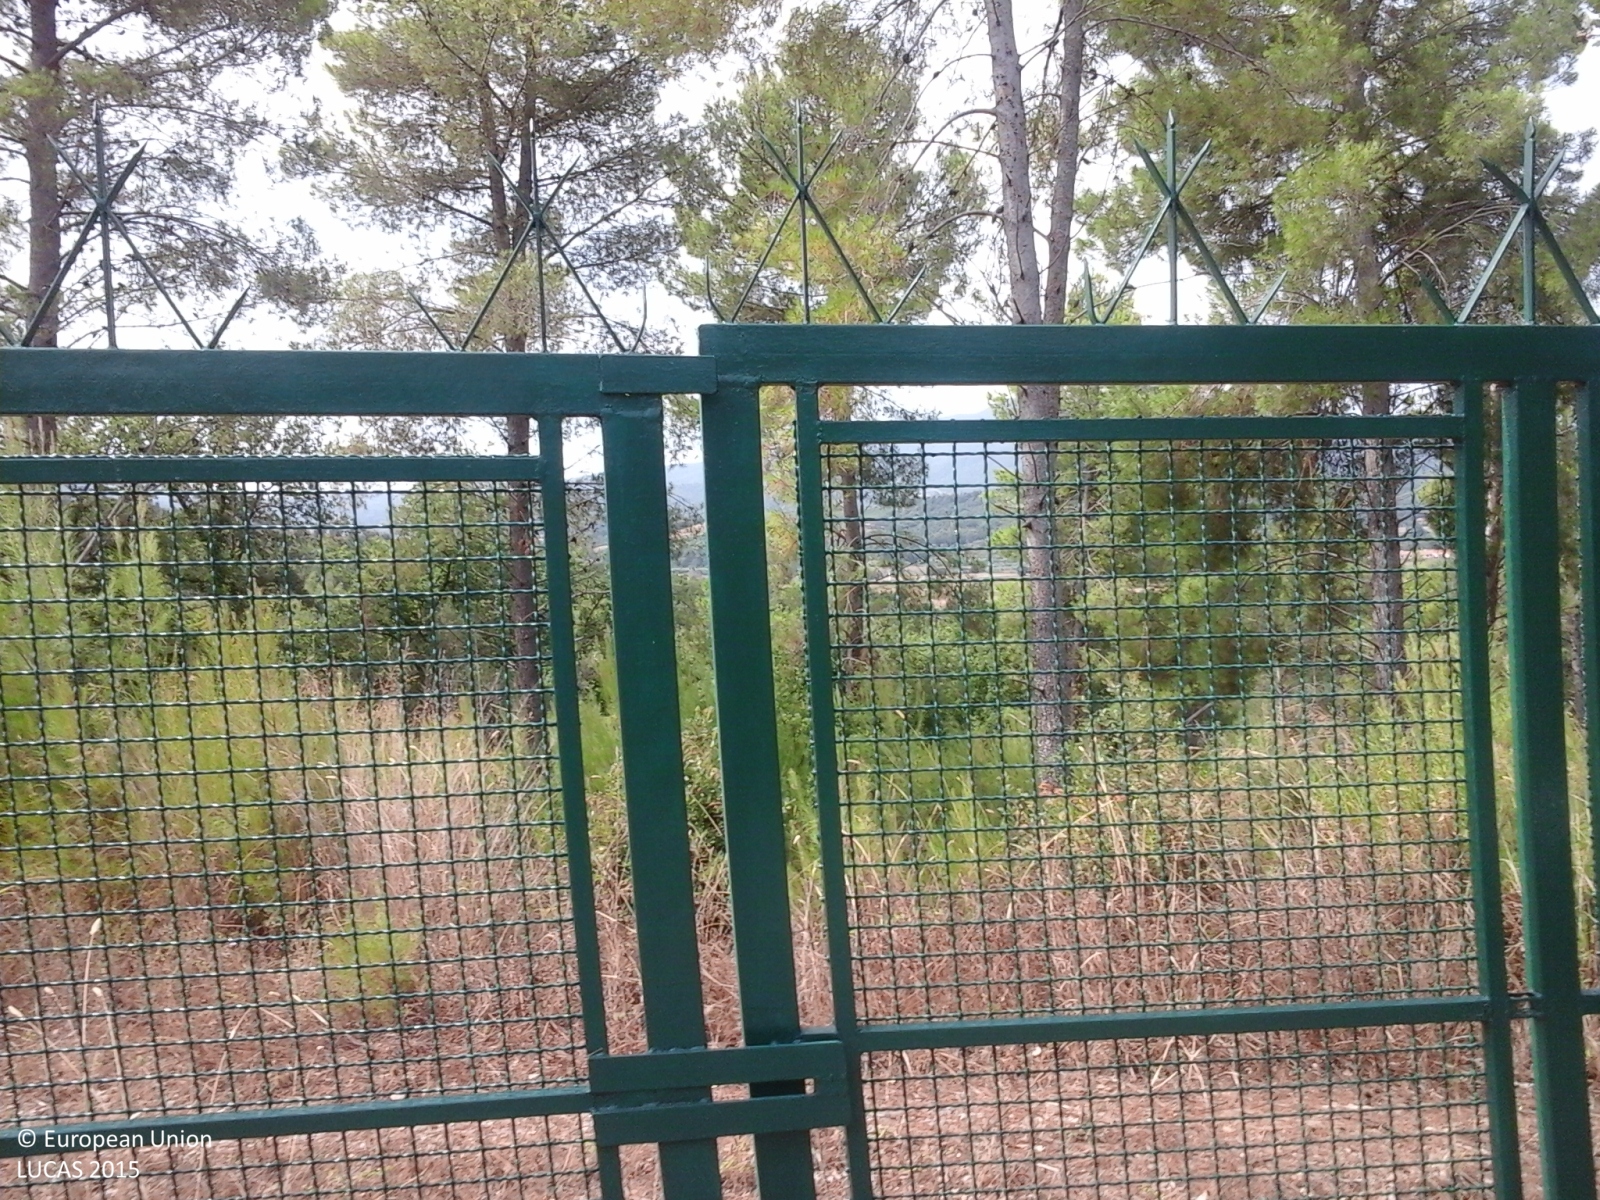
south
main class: Woodland
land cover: Broadleaved woodland
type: broadleaved evergreen forest
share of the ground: > 75 %
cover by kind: broadleaved forest trees 80 %, coniferous forest trees 20 %
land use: Forestry
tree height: > 5 m
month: August
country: IT
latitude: 42.9023
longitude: 10.9645
